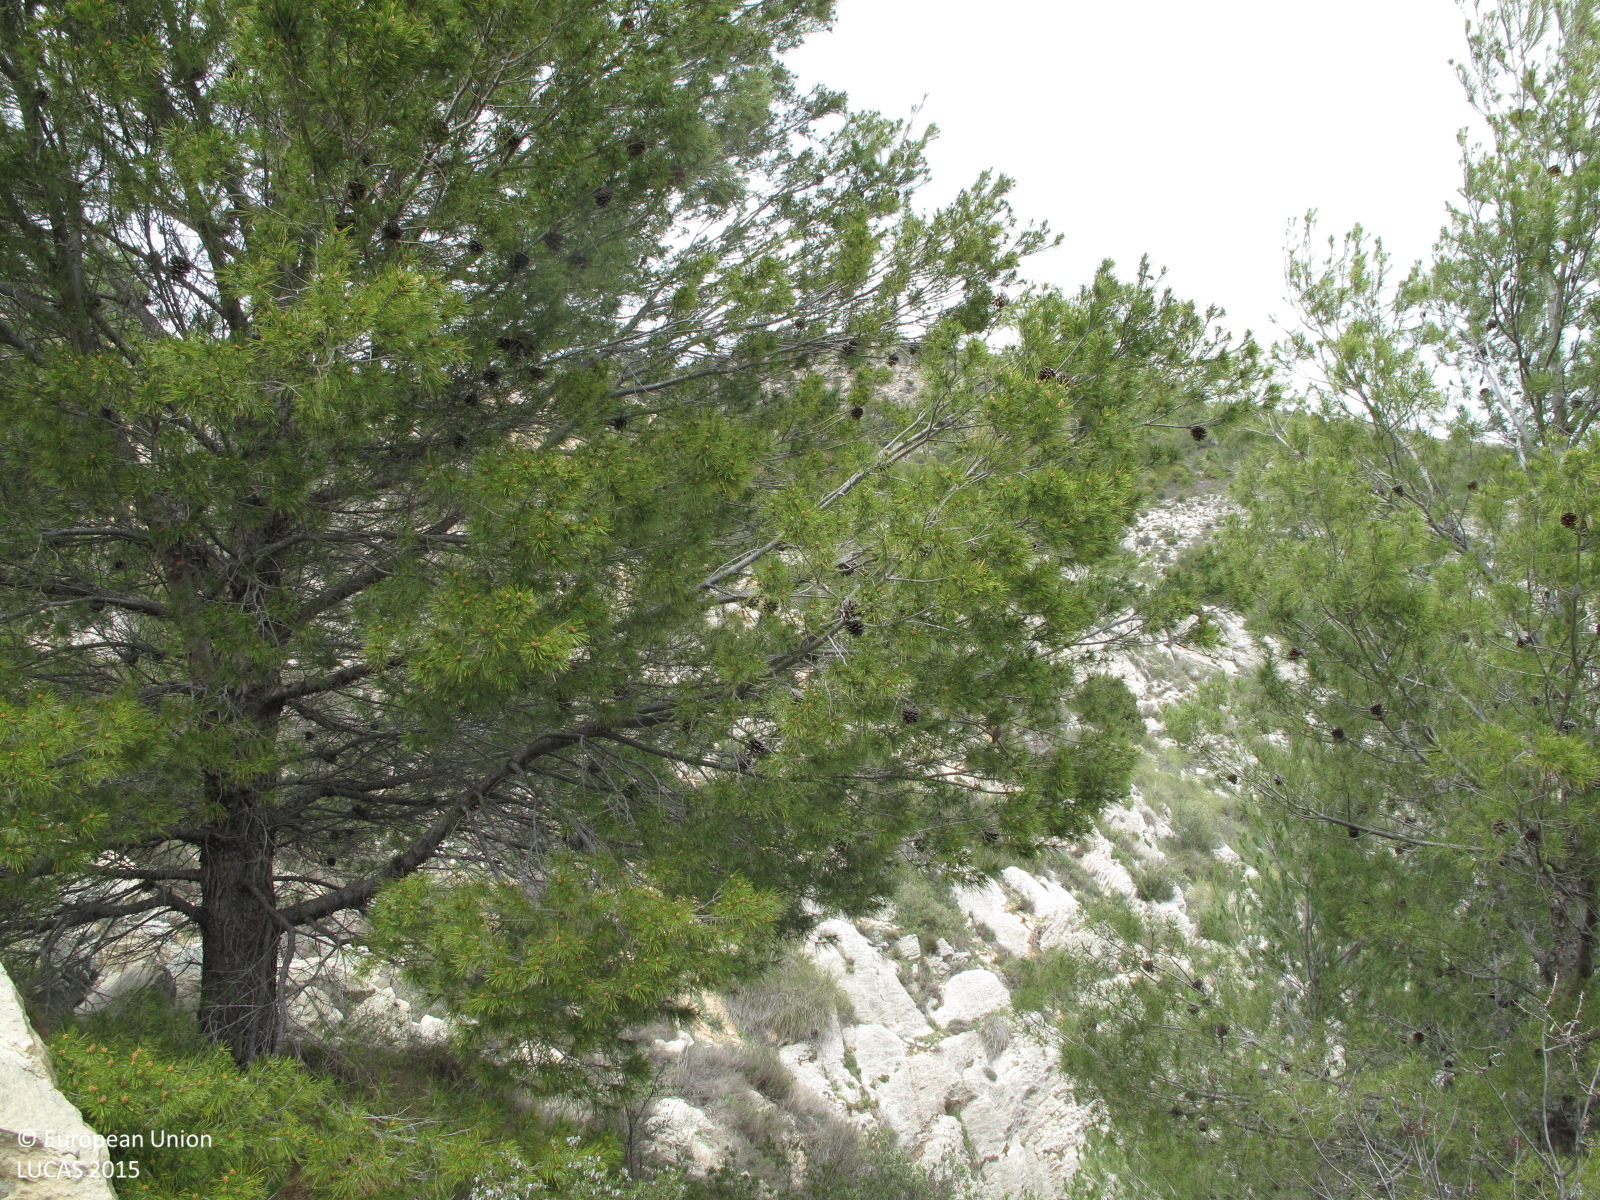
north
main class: Woodland
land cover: Pine dominated coniferous woodland
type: coniferous forest of the mediterranean region
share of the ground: 25 - 50 %
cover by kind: herbaceous plants 50 %, coniferous forest trees 30 %, shrubs 10 %, consolidated bare surface 10 %
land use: Semi-natural and natural areas not in use
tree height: > 5 m
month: March
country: ES
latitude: 38.7387
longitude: -0.4703
